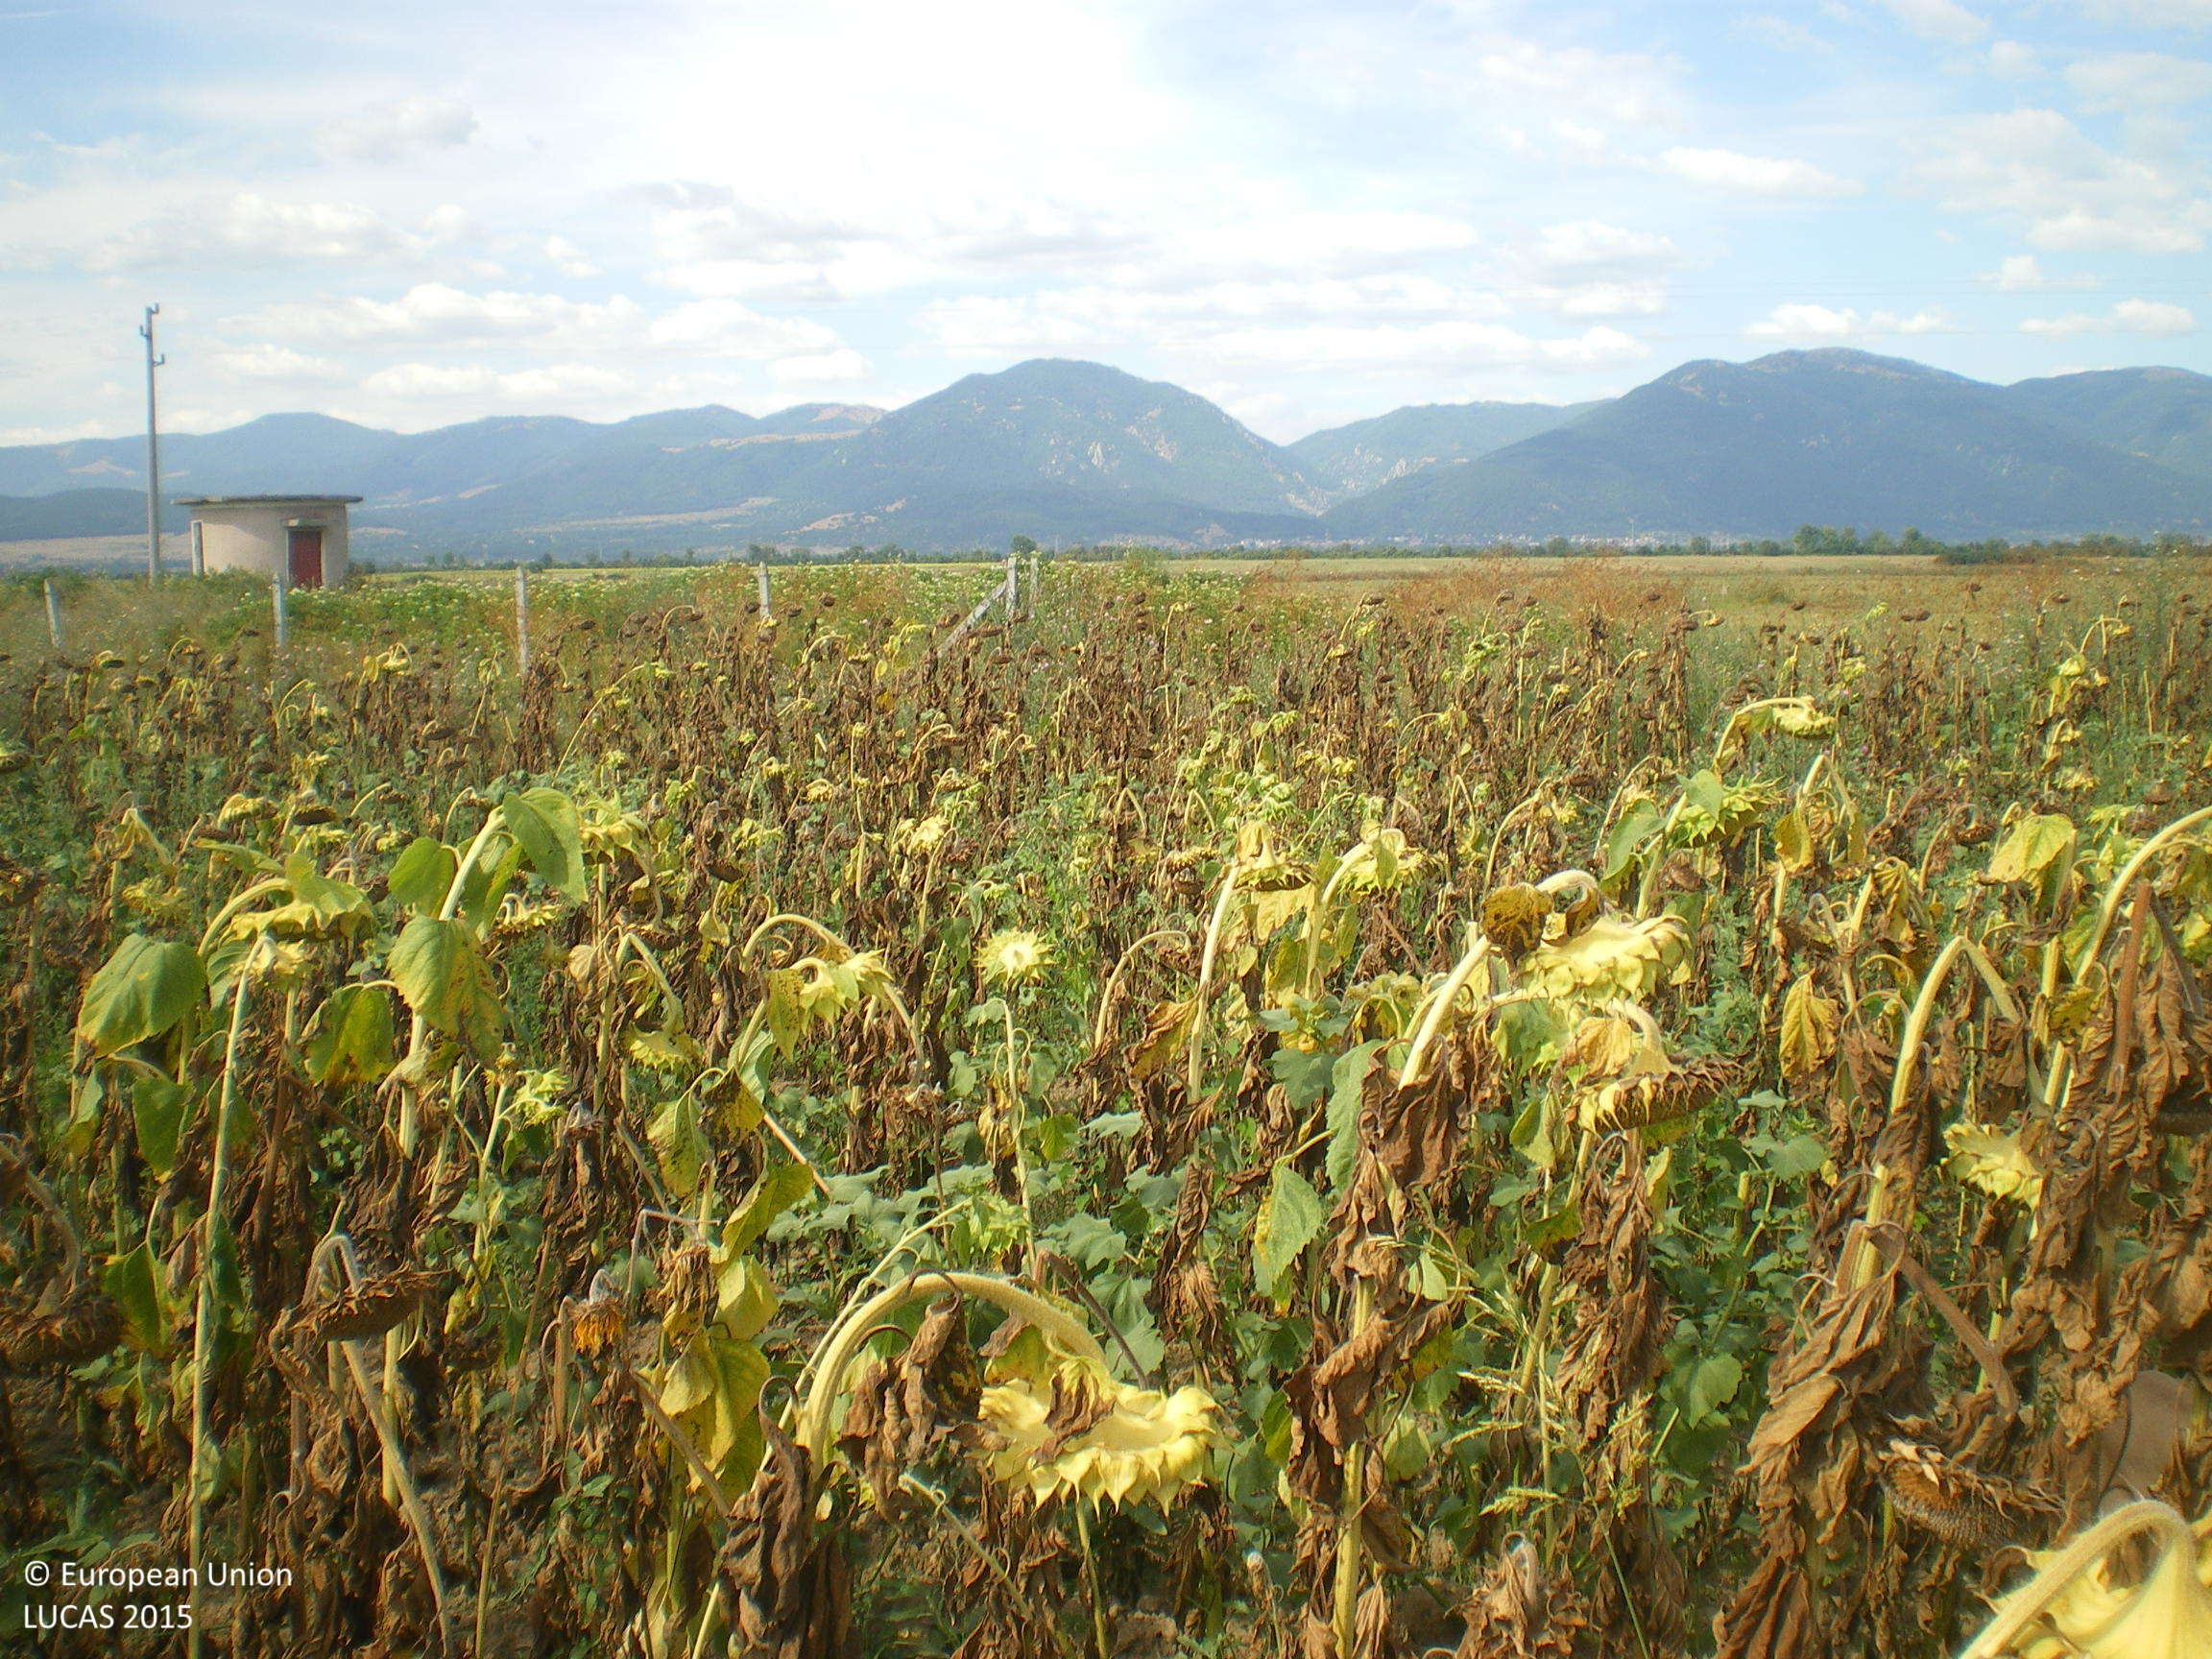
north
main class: Cropland
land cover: Sunflower
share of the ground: > 75 %
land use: Agriculture (excluding fallow land and kitchen gardens)
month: August
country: BG
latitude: 42.5497
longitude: 25.5254
